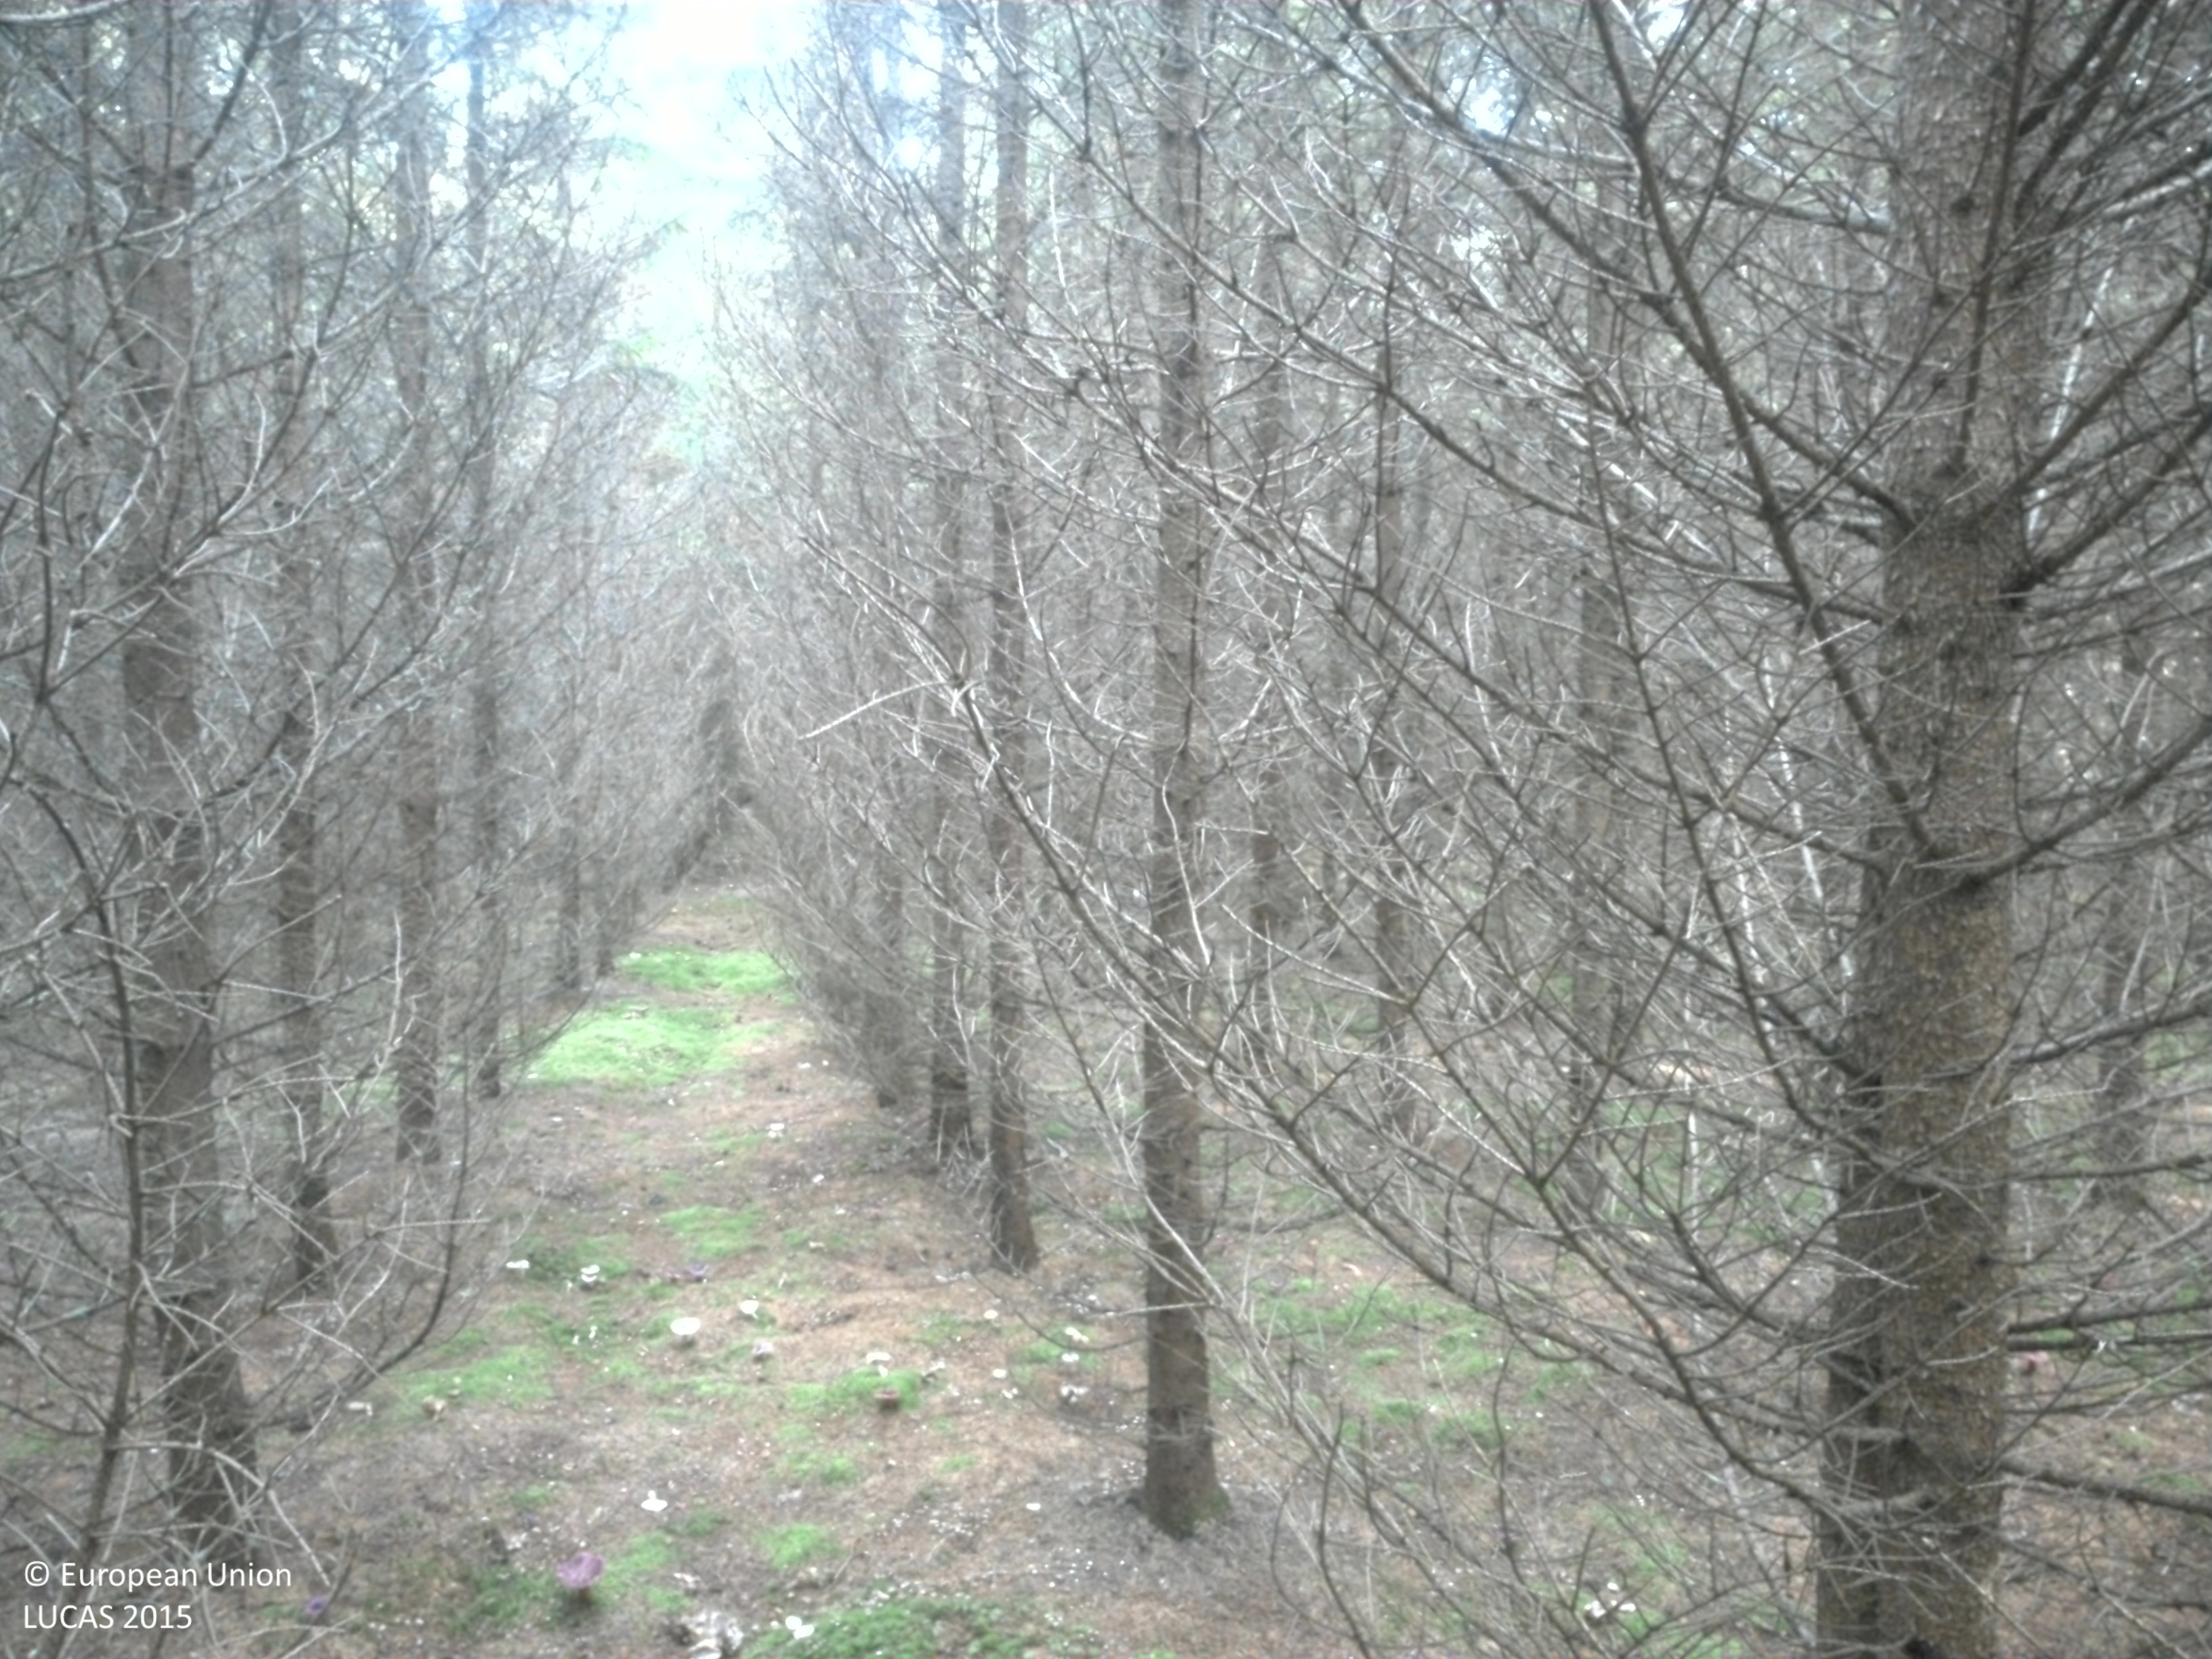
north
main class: Woodland
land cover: Spruce dominated coniferous woodland
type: boreal forest
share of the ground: > 75 %
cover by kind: coniferous forest trees 85 %, lichens and mosses 15 %
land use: Forestry
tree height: > 5 m
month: September
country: SE
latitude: 59.4800
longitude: 15.4462
